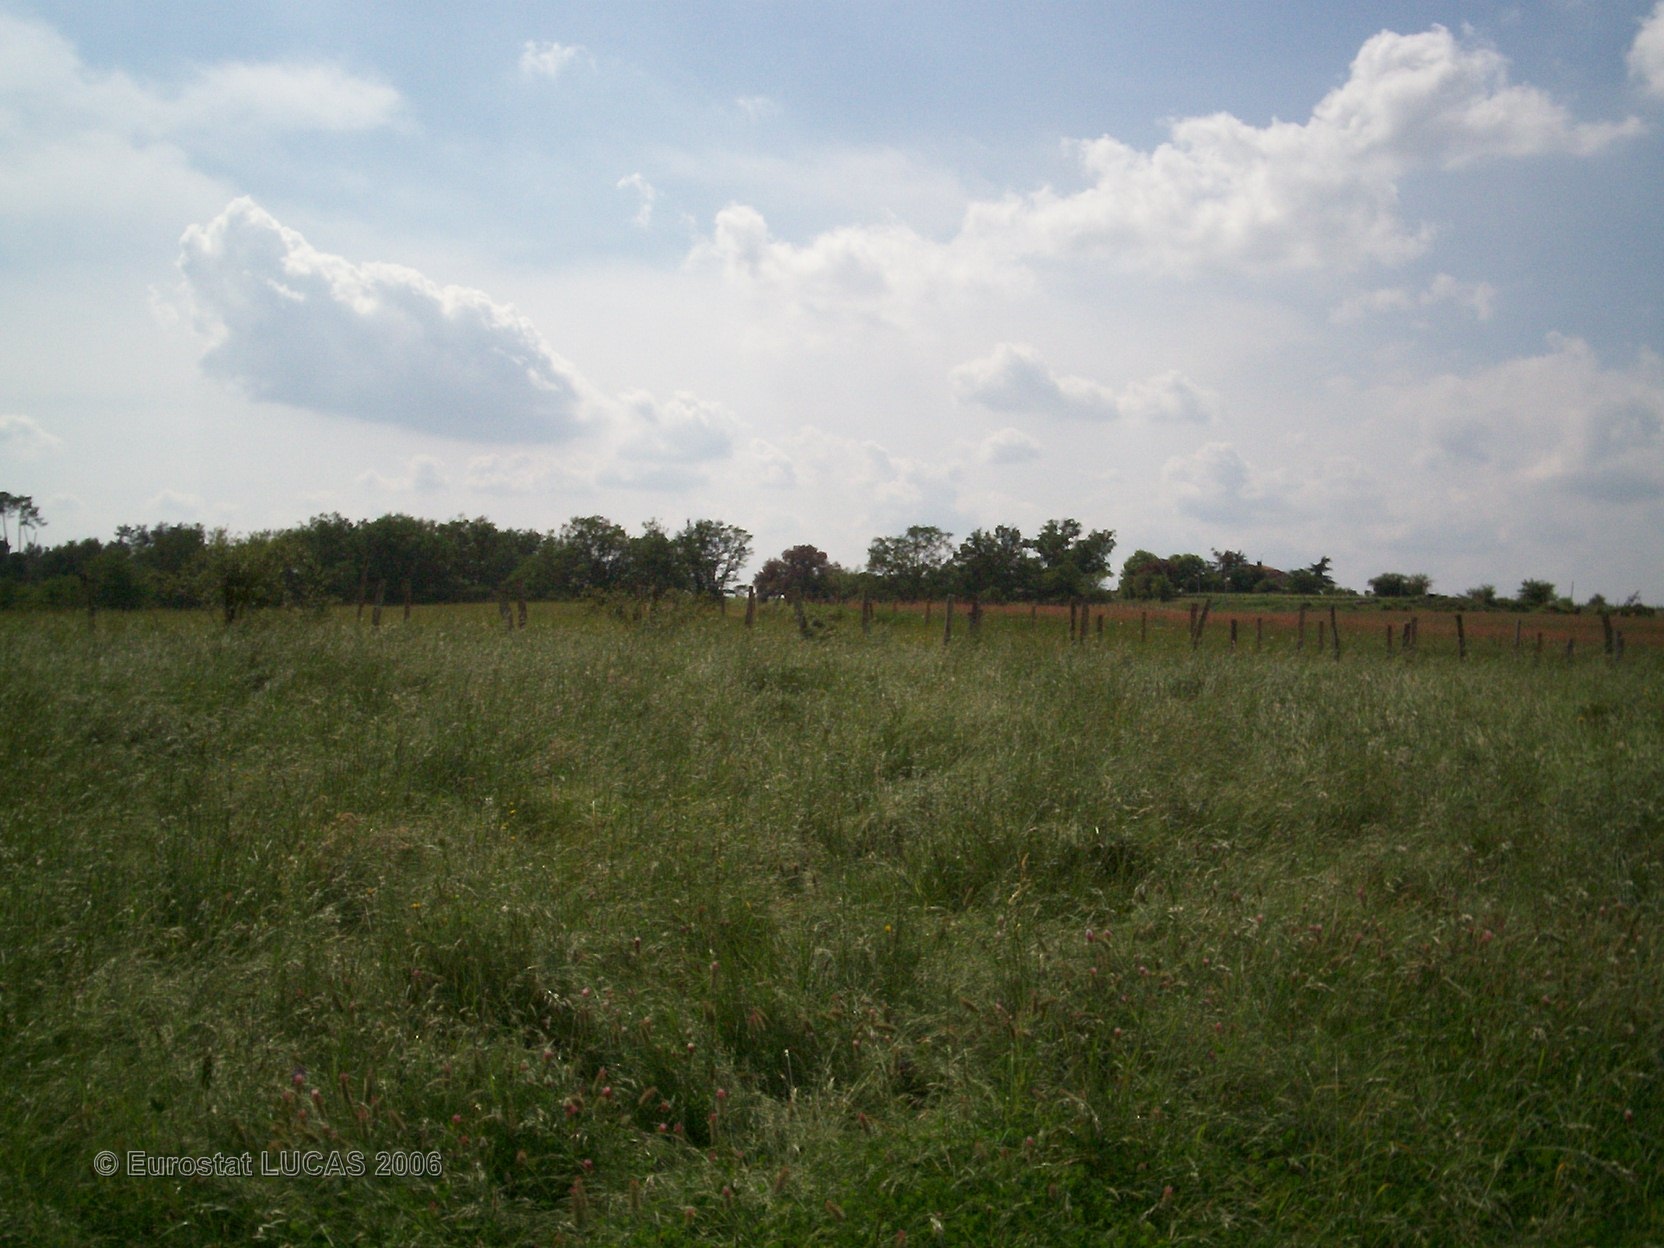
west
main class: Grassland
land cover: Grassland without tree/shrub cover
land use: Agriculture (excluding fallow land and kitchen gardens)
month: May
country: FR
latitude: 45.1482
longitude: -0.0763
